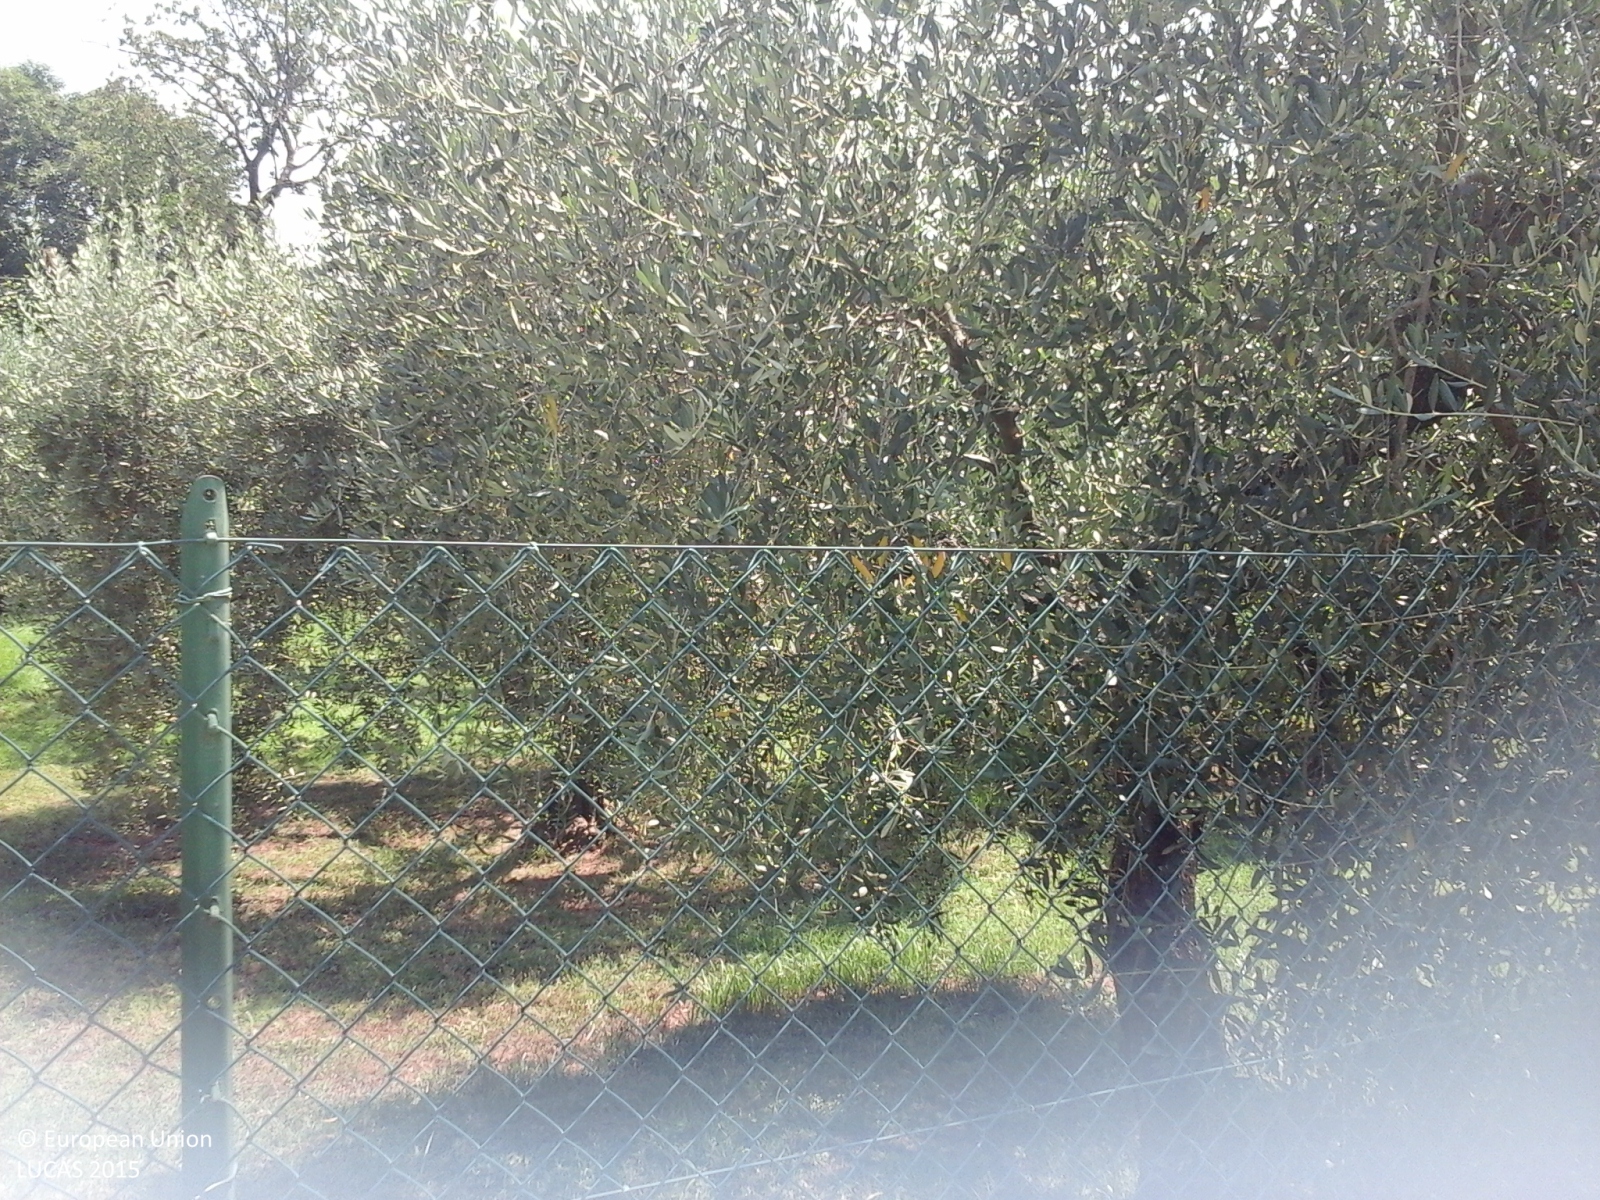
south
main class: Cropland
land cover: Olive groves
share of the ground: 50 - 75 %
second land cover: Grassland without tree/shrub cover
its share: > 75 %
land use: Kitchen garden
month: July
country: IT
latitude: 41.6930
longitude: 12.8128
